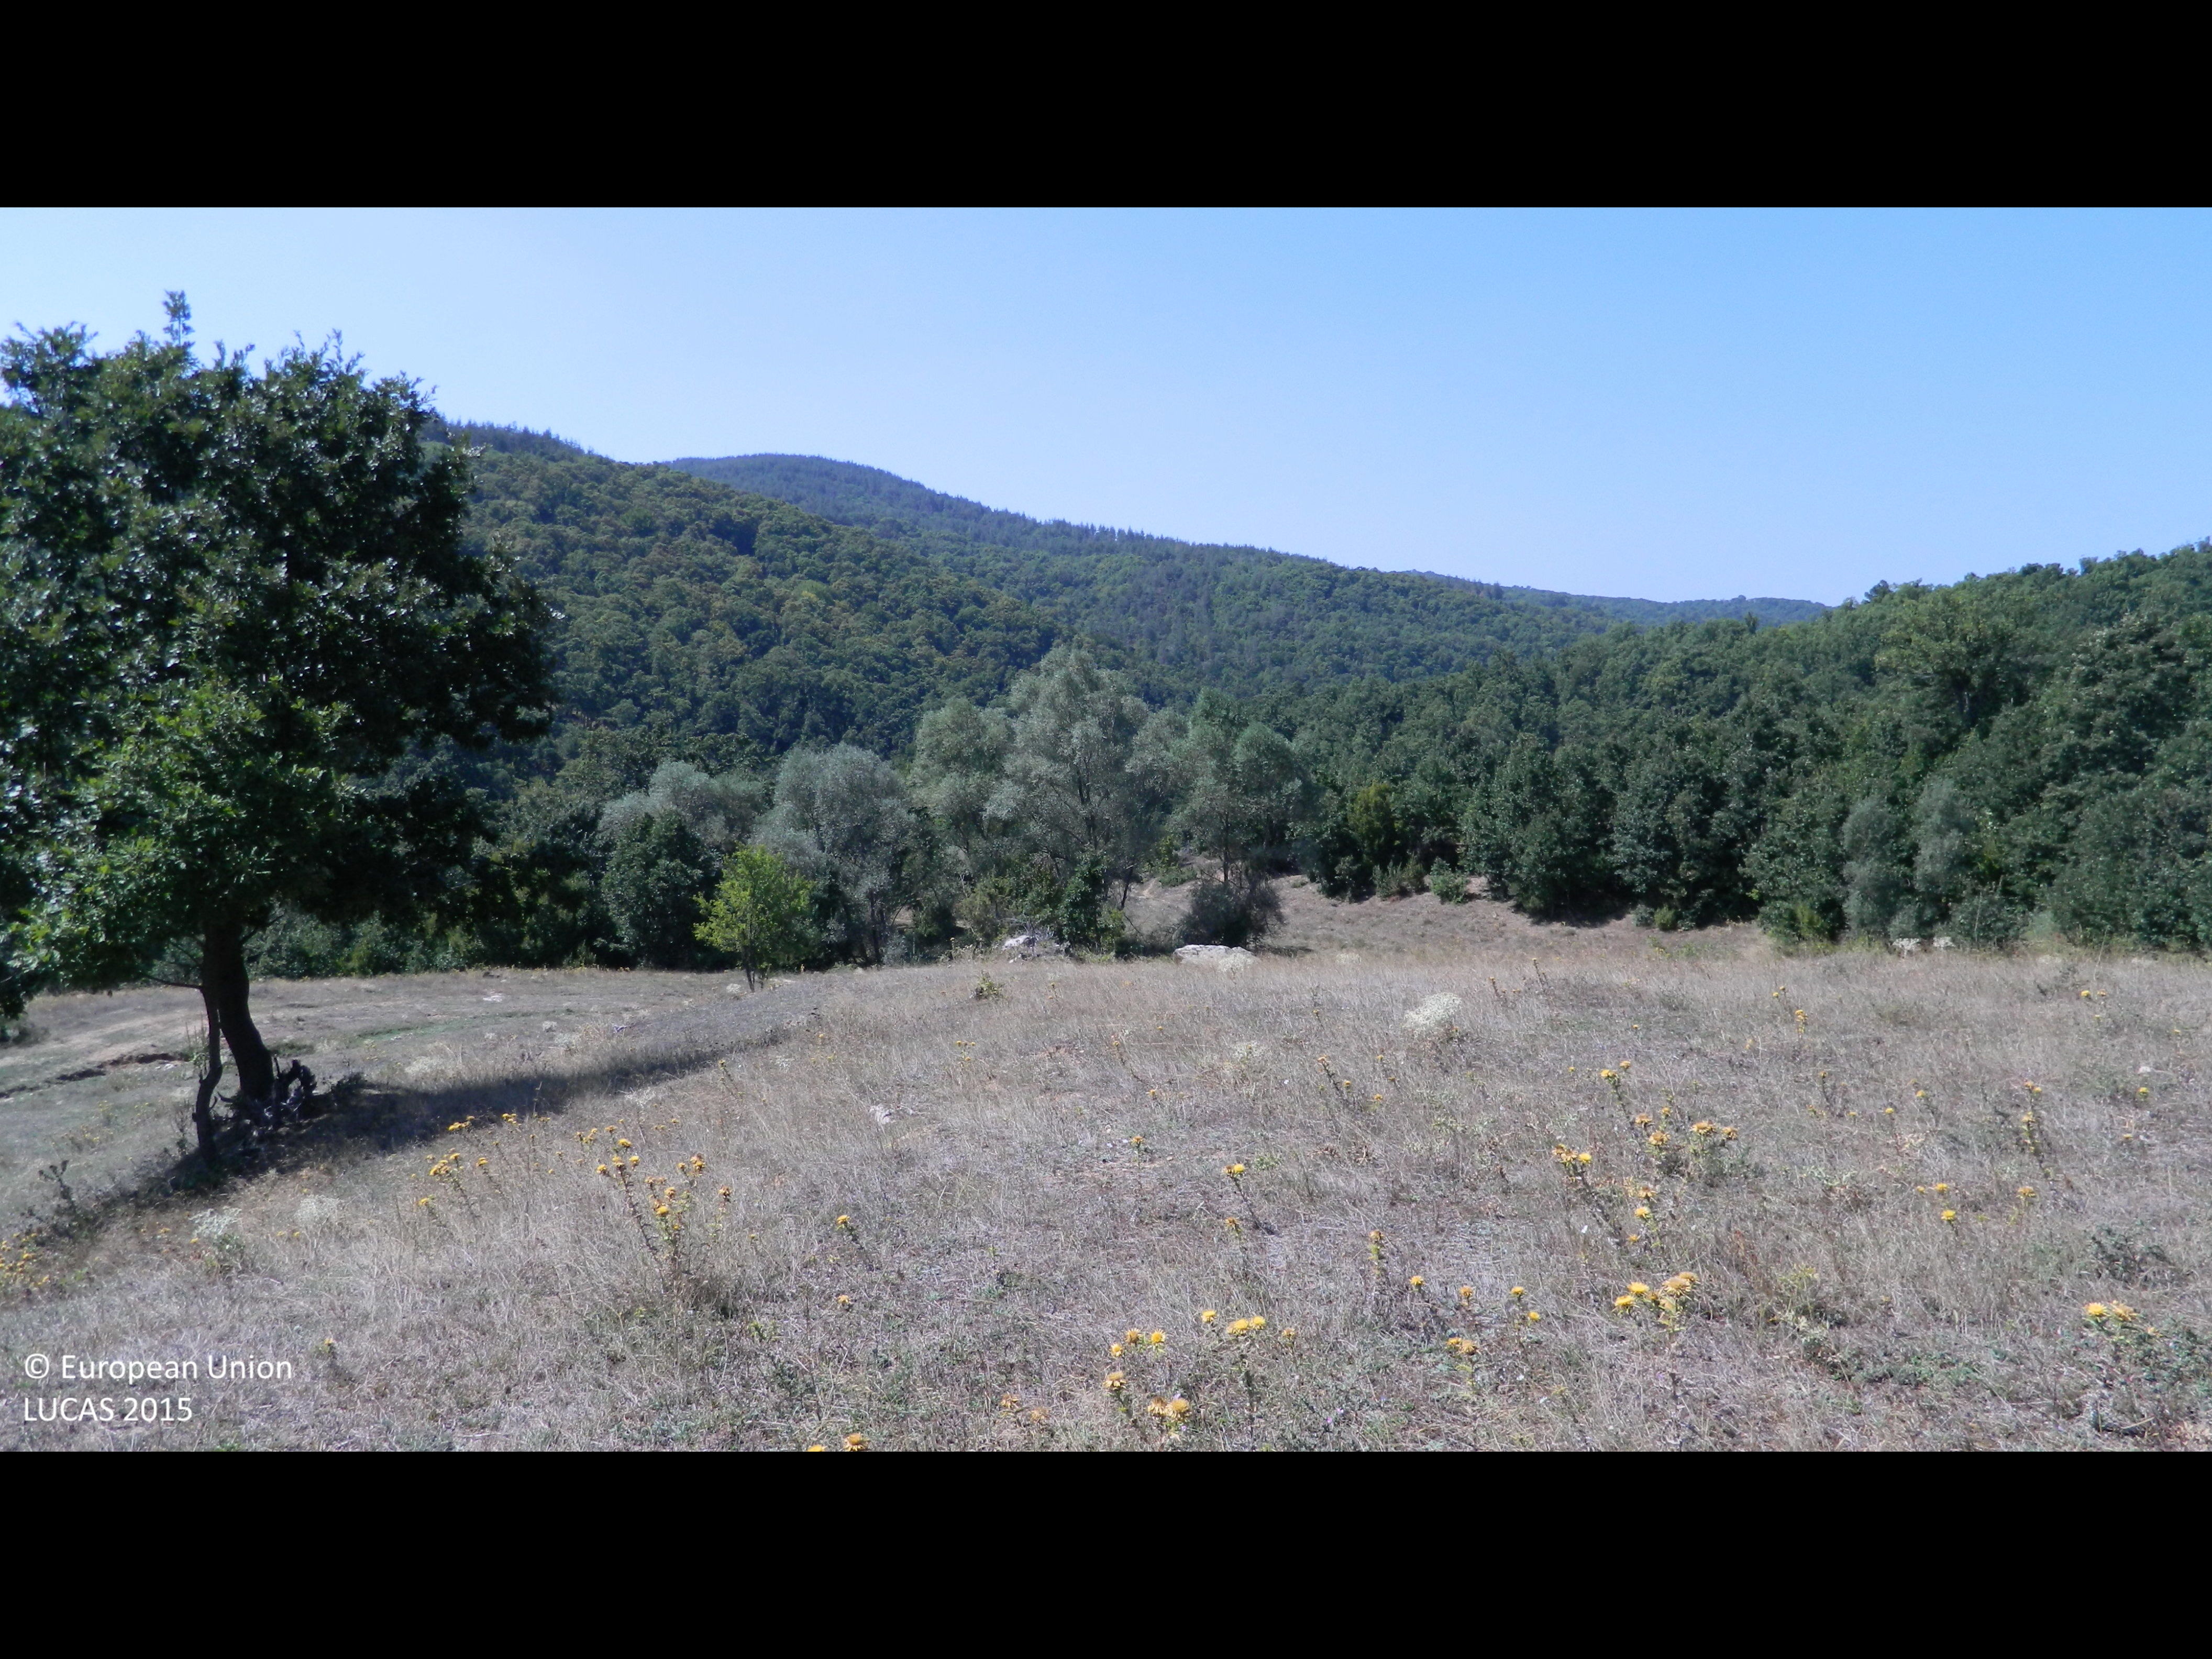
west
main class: Grassland
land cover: Grassland without tree/shrub cover
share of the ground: > 75 %
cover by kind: herbaceous plants 95 %, shrubs 5 %
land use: Agriculture (excluding fallow land and kitchen gardens)
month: August
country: BG
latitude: 41.5357
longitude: 25.8997
